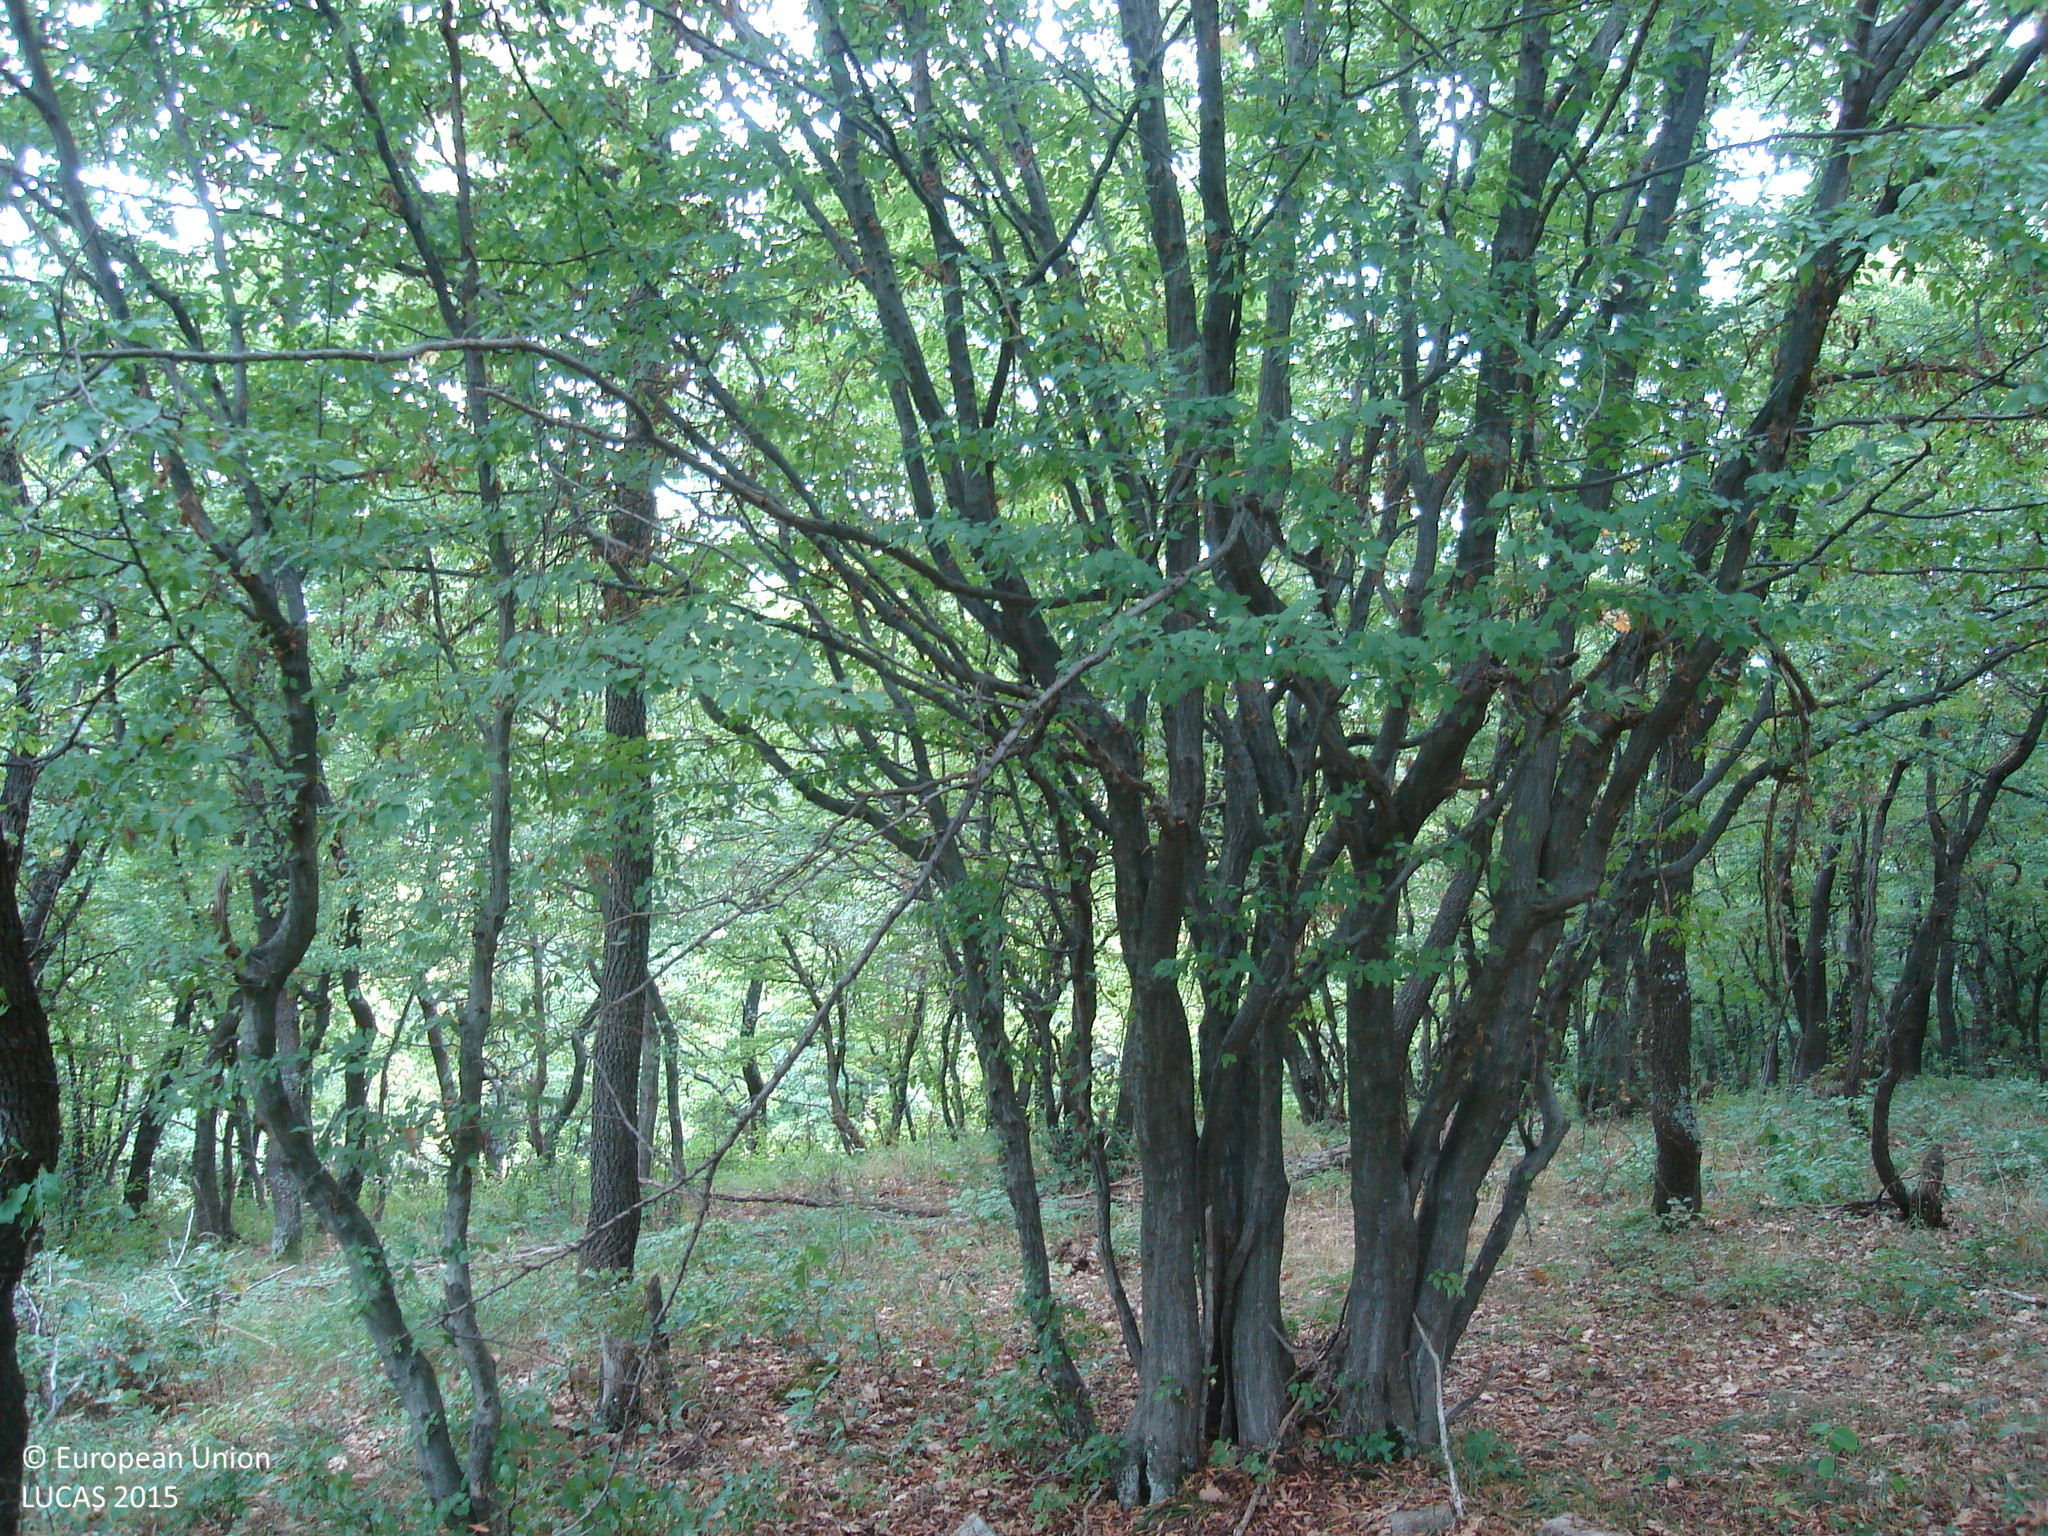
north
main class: Woodland
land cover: Broadleaved woodland
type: thermophilous deciduous forest
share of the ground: 50 - 75 %
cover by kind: broadleaved forest trees 65 %, herbaceous plants 25 %, shrubs 5 %, consolidated bare surface 5 %
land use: Forestry
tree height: > 5 m
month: September
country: BG
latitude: 42.6515
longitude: 23.9615
